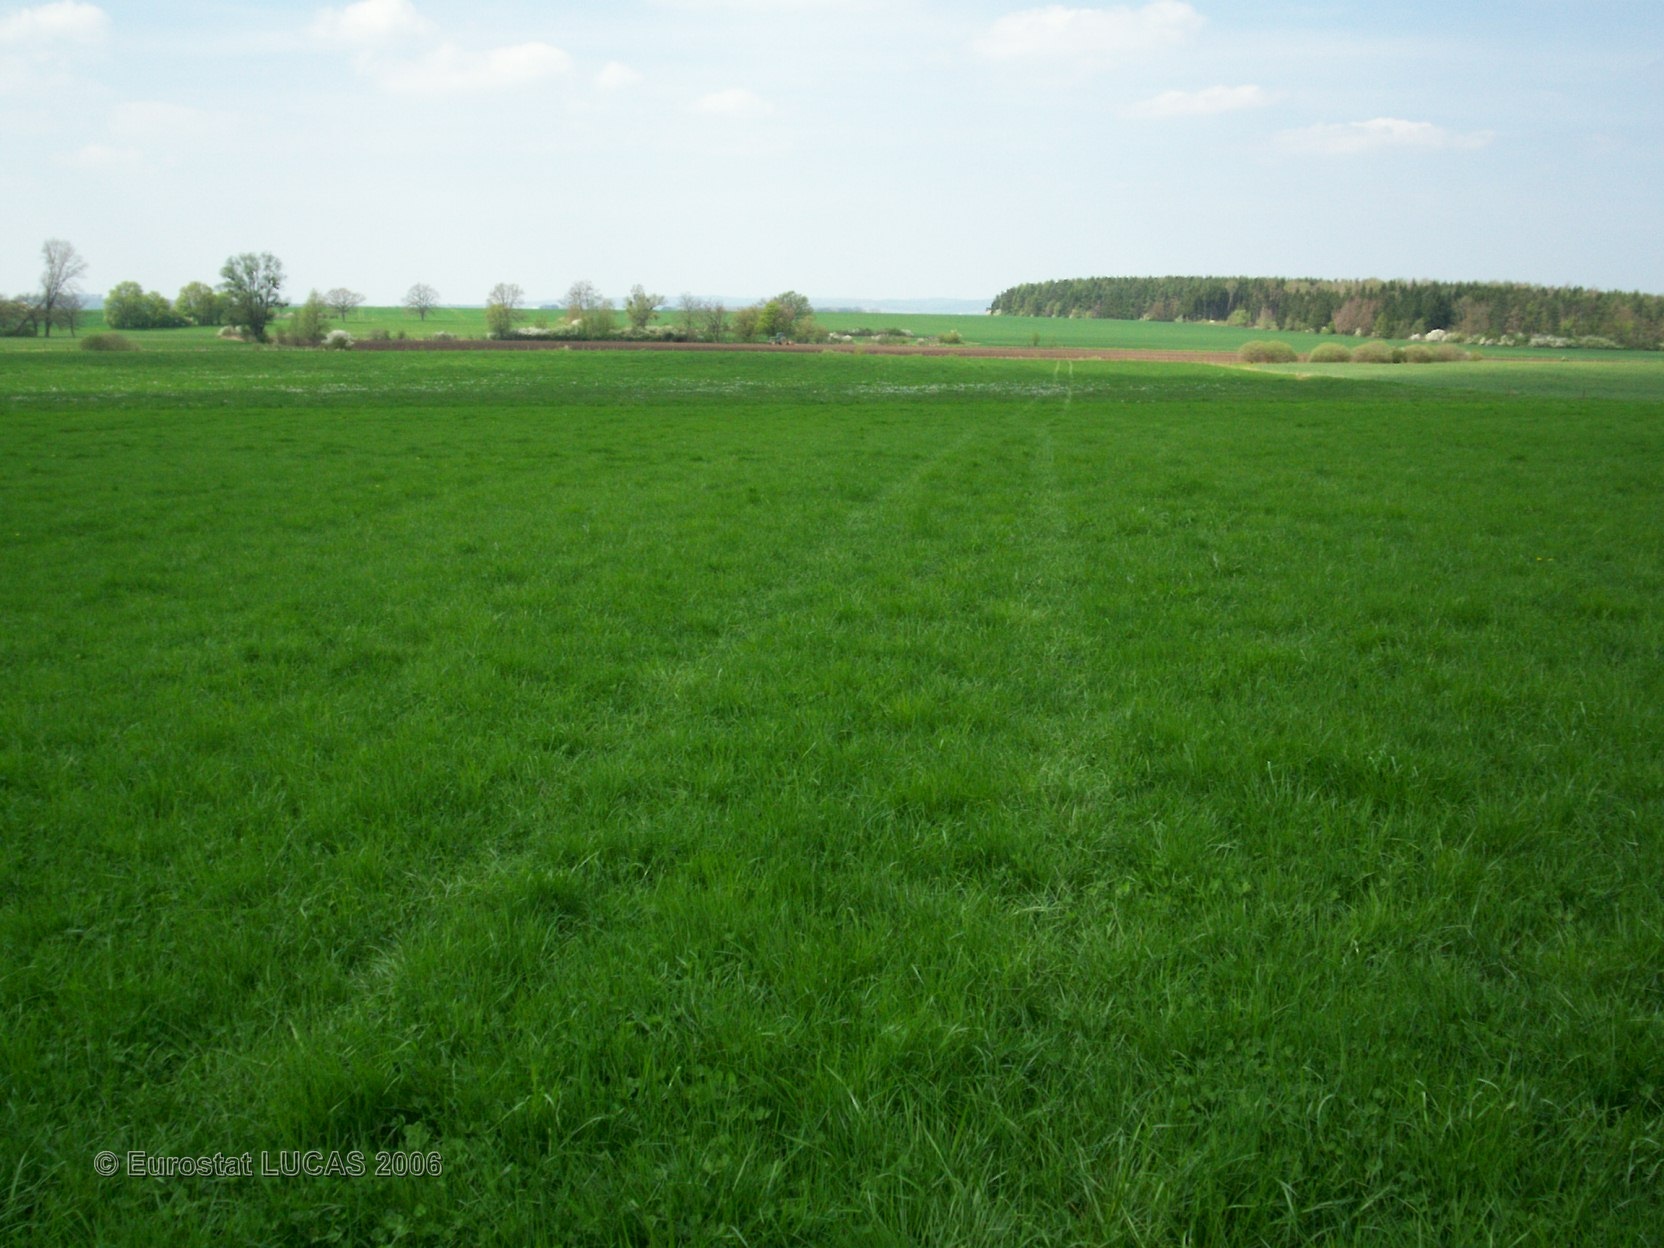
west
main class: Grassland
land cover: Grassland without tree/shrub cover
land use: Agriculture (excluding fallow land and kitchen gardens)
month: April
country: FR
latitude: 48.9863
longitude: 6.7617
